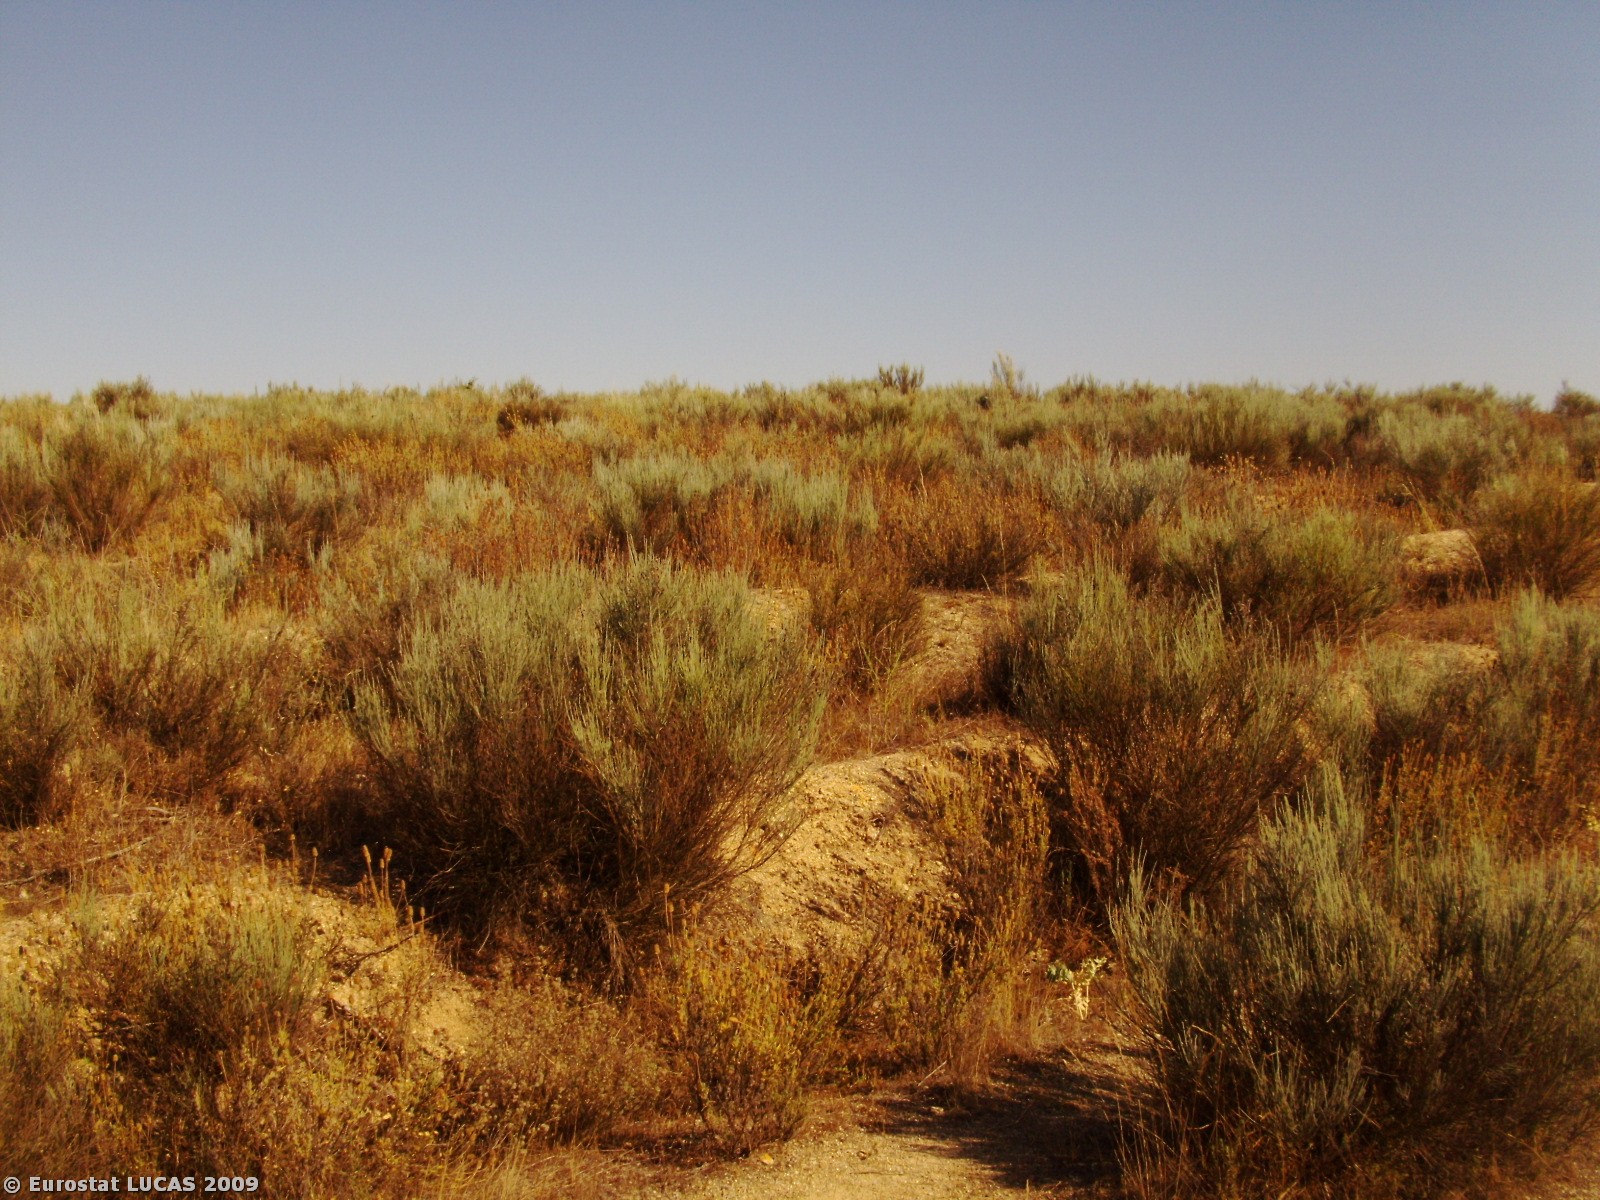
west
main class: Shrubland
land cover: Shrubland with sparse tree cover
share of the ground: > 75 %
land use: Forestry
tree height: > 5 m
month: July
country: PT
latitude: 40.5299
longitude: -7.0647
